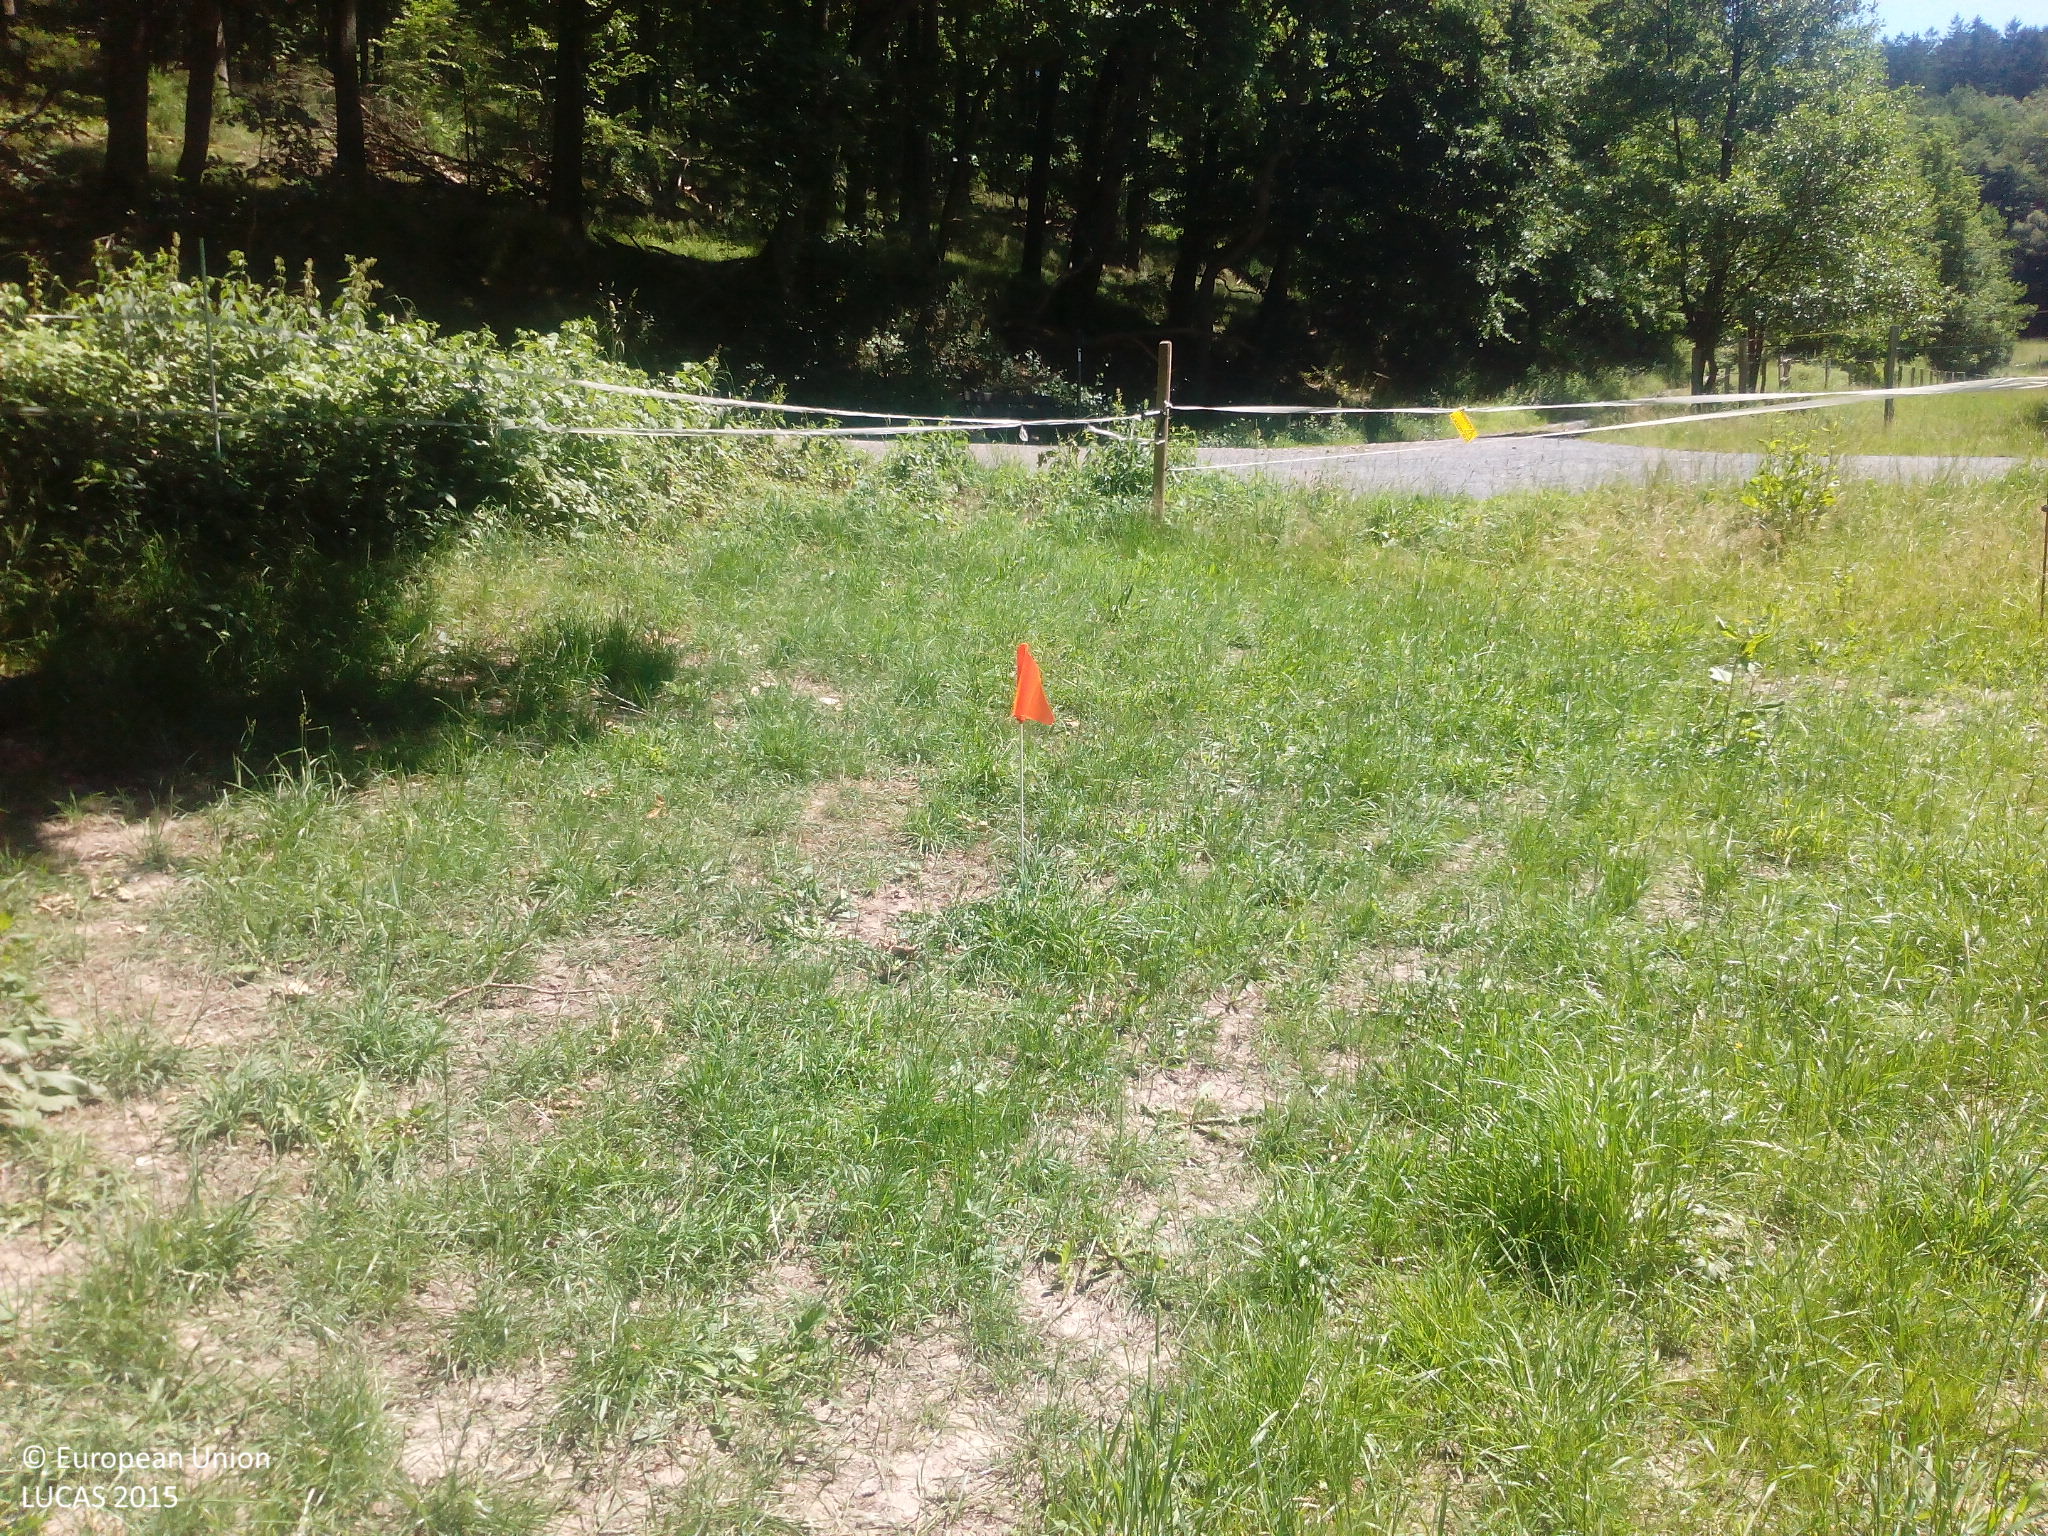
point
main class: Grassland
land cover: Grassland without tree/shrub cover
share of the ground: 50 - 75 %
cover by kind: herbaceous plants 60 %, unconsolidated bare surface 40 %
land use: Agriculture (excluding fallow land and kitchen gardens)
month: June
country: DE
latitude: 50.2819
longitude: 8.4707
